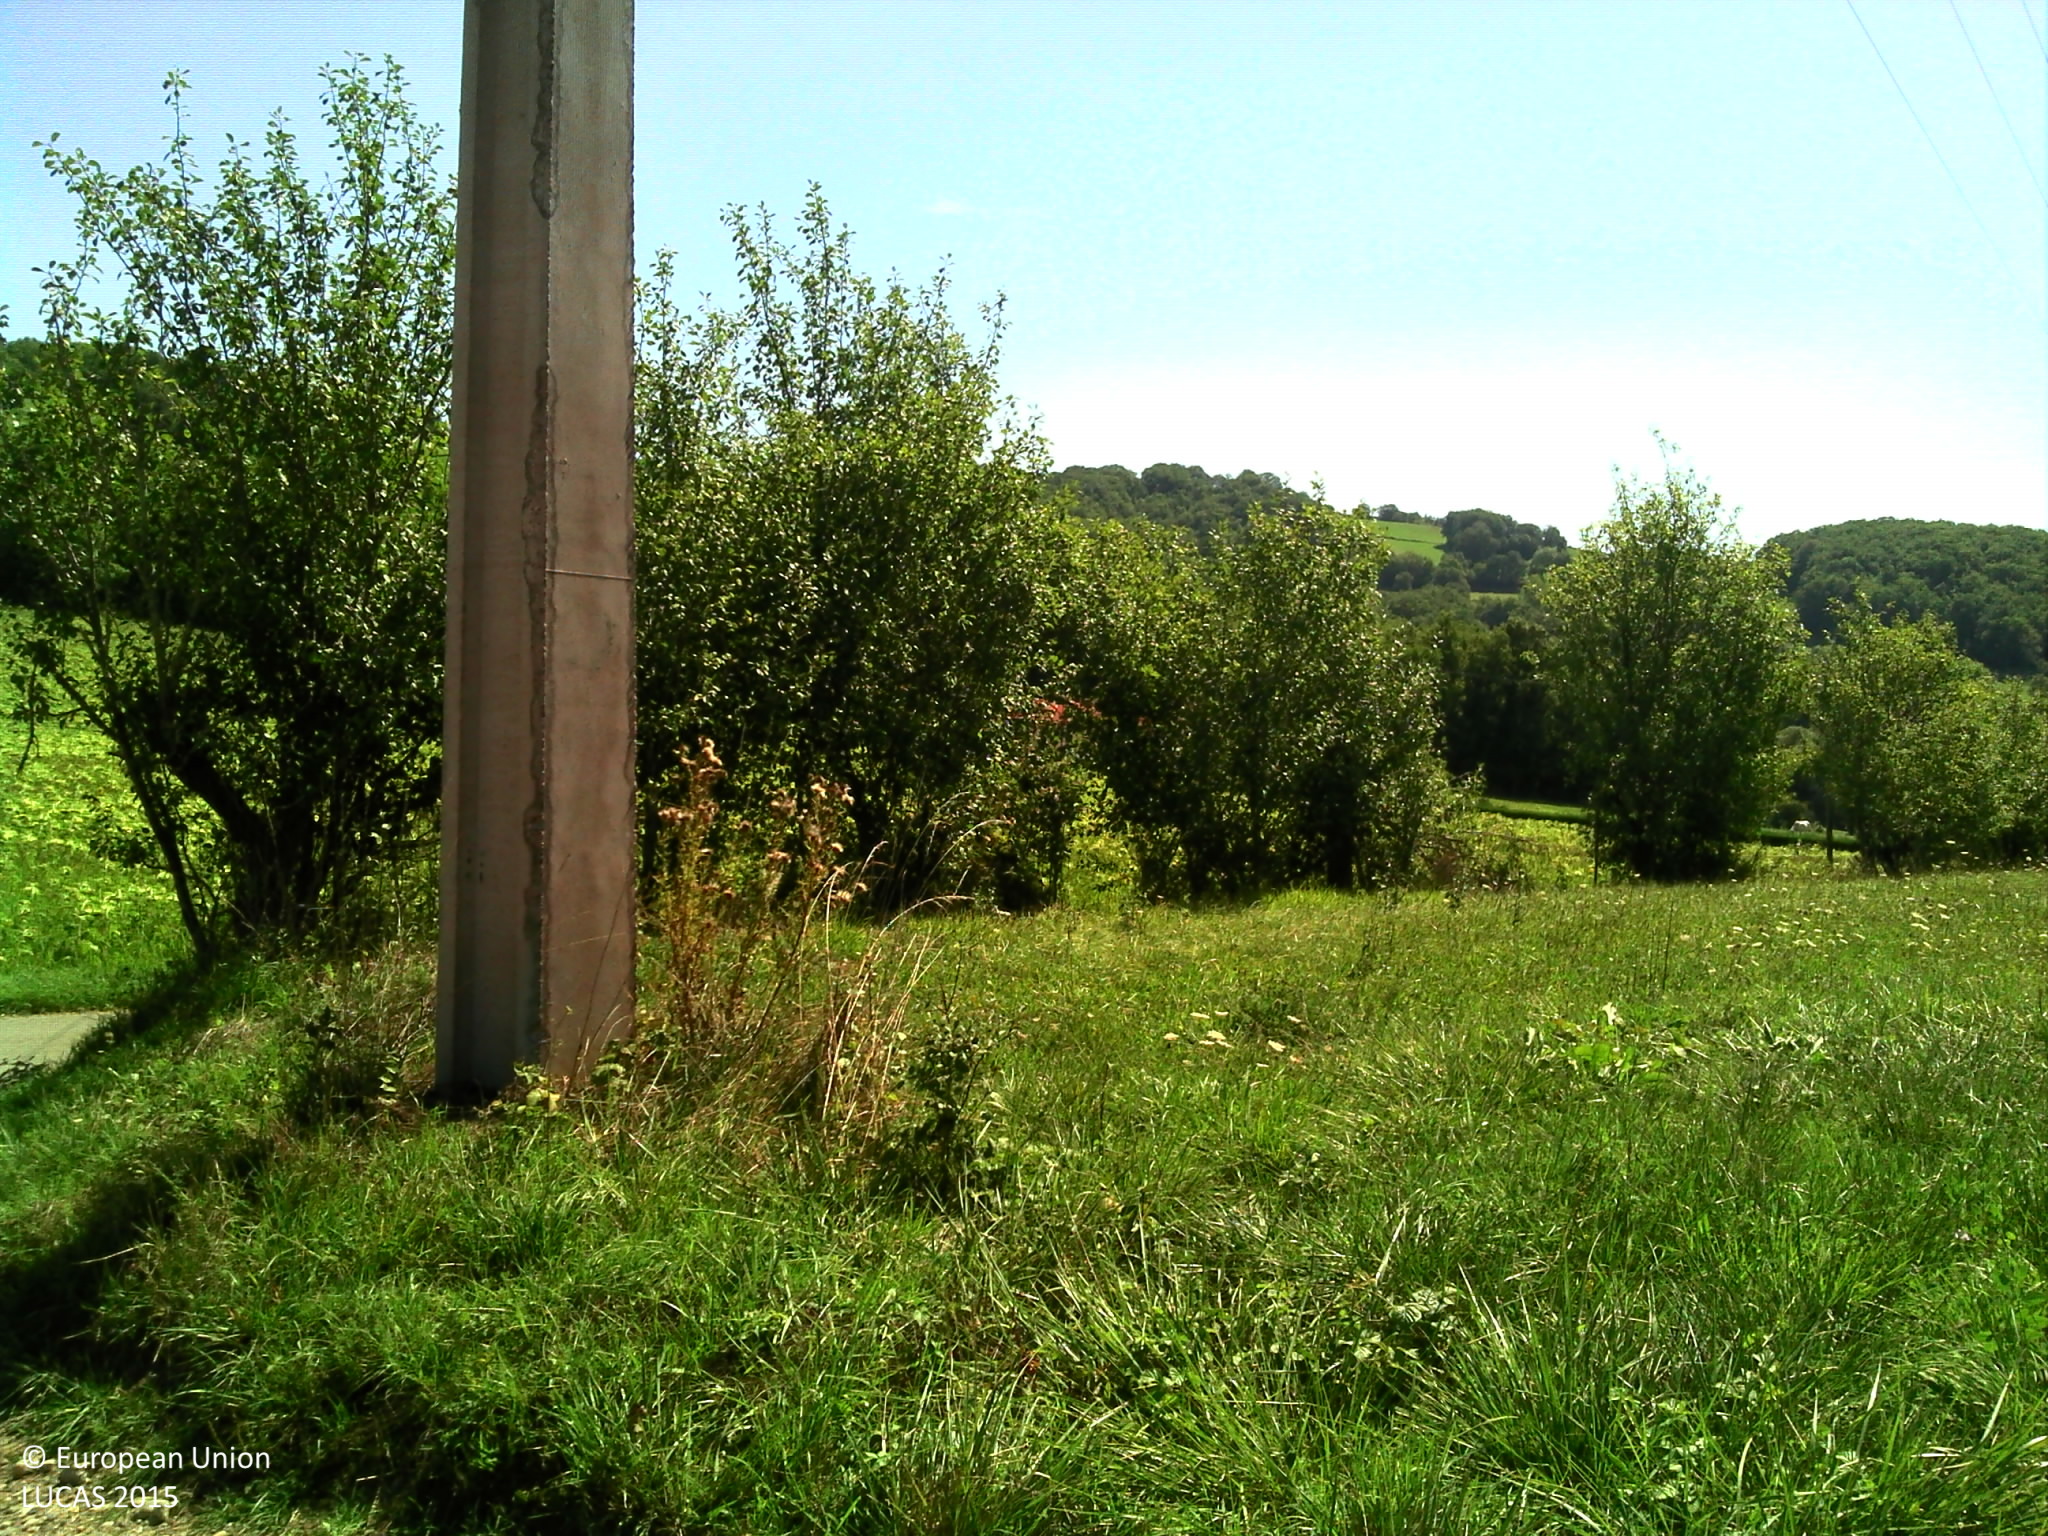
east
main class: Grassland
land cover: Grassland without tree/shrub cover
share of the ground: > 75 %
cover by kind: herbaceous plants 100 %
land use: Agriculture (excluding fallow land and kitchen gardens)
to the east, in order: Grassland without tree/shrub cover; Artificial constructions in urban areas; Grassland without tree/shrub cover; Lines of trees; Grassland without tree/shrub cover; Electric lines; Managed hedges; Ditches and canals; Paved roads, cycling and walking lanes; Grass margins; Electric lines; Sunflower; Conifer hedges; Tracks; Fences; Grassland without tree/shrub cover; Fences; Grassland with sparse tree/shrub cover
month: August
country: FR
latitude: 44.1792
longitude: 1.9086
